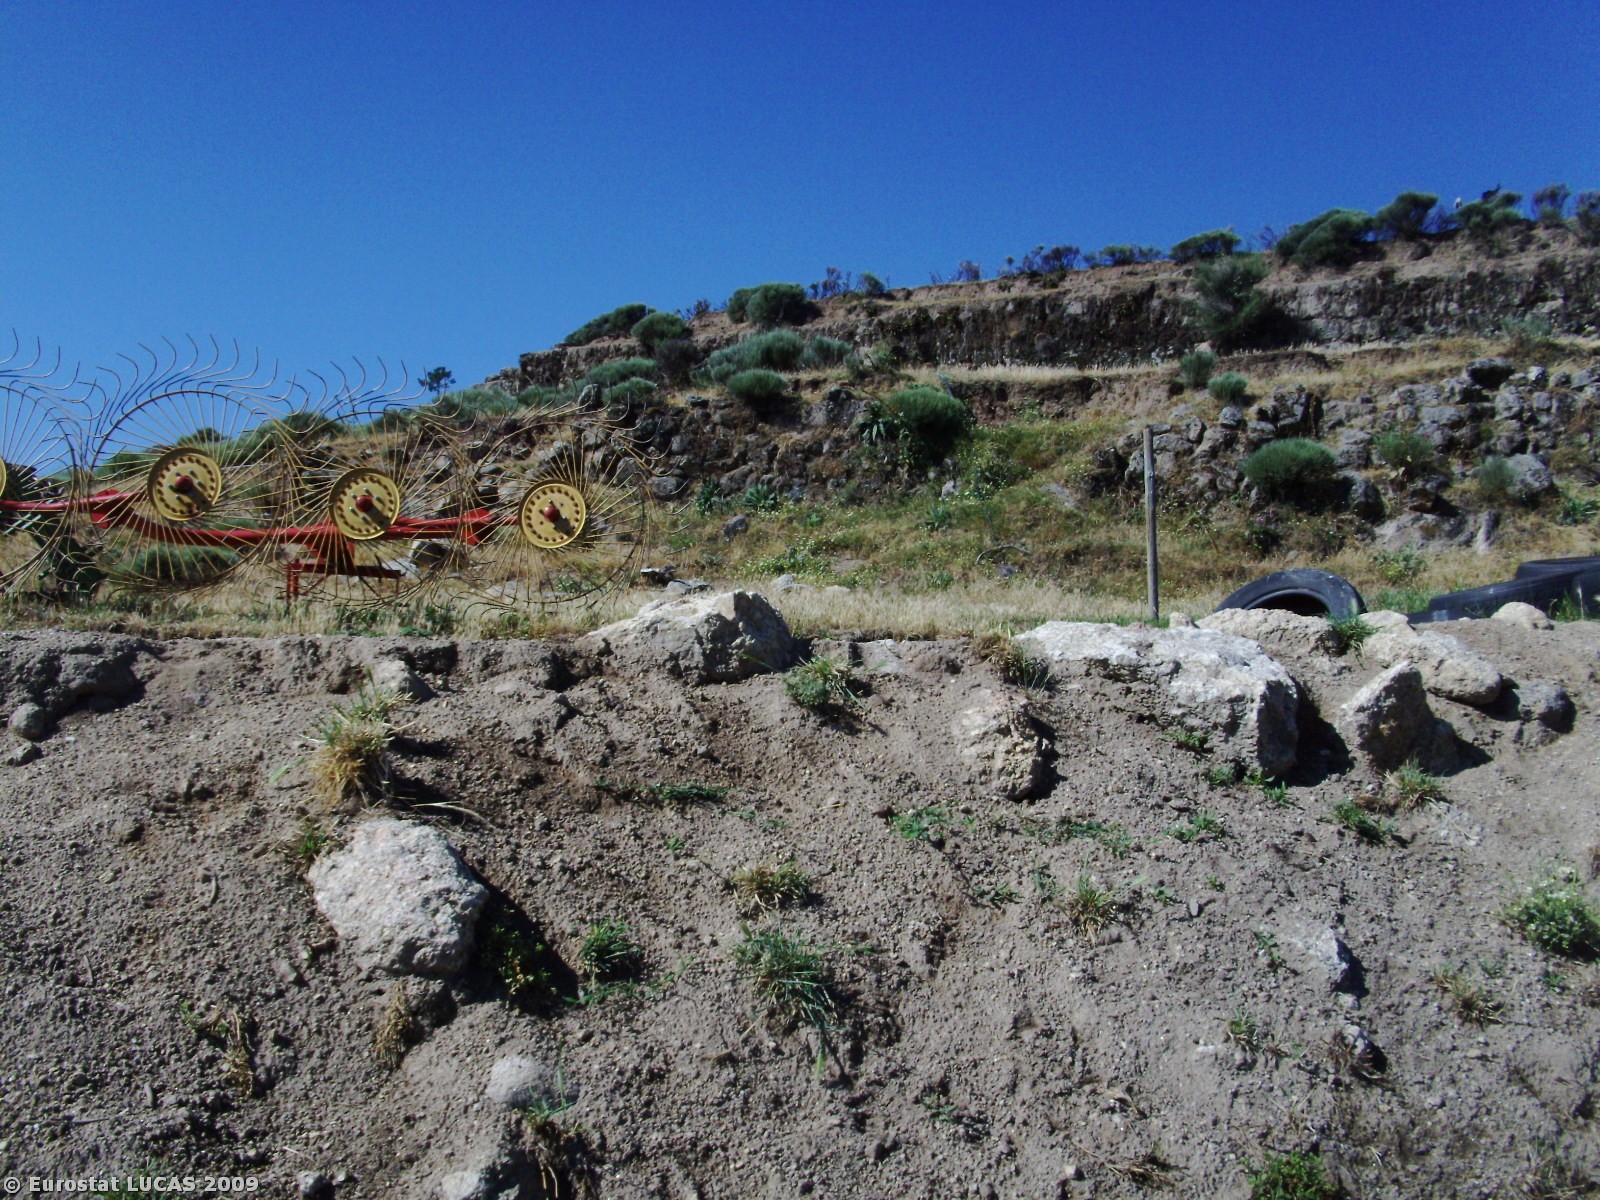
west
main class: Grassland
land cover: Spontaneously vegetated surfaces
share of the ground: > 75 %
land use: Fallow land
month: July
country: PT
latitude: 40.2640
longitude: -7.5221
